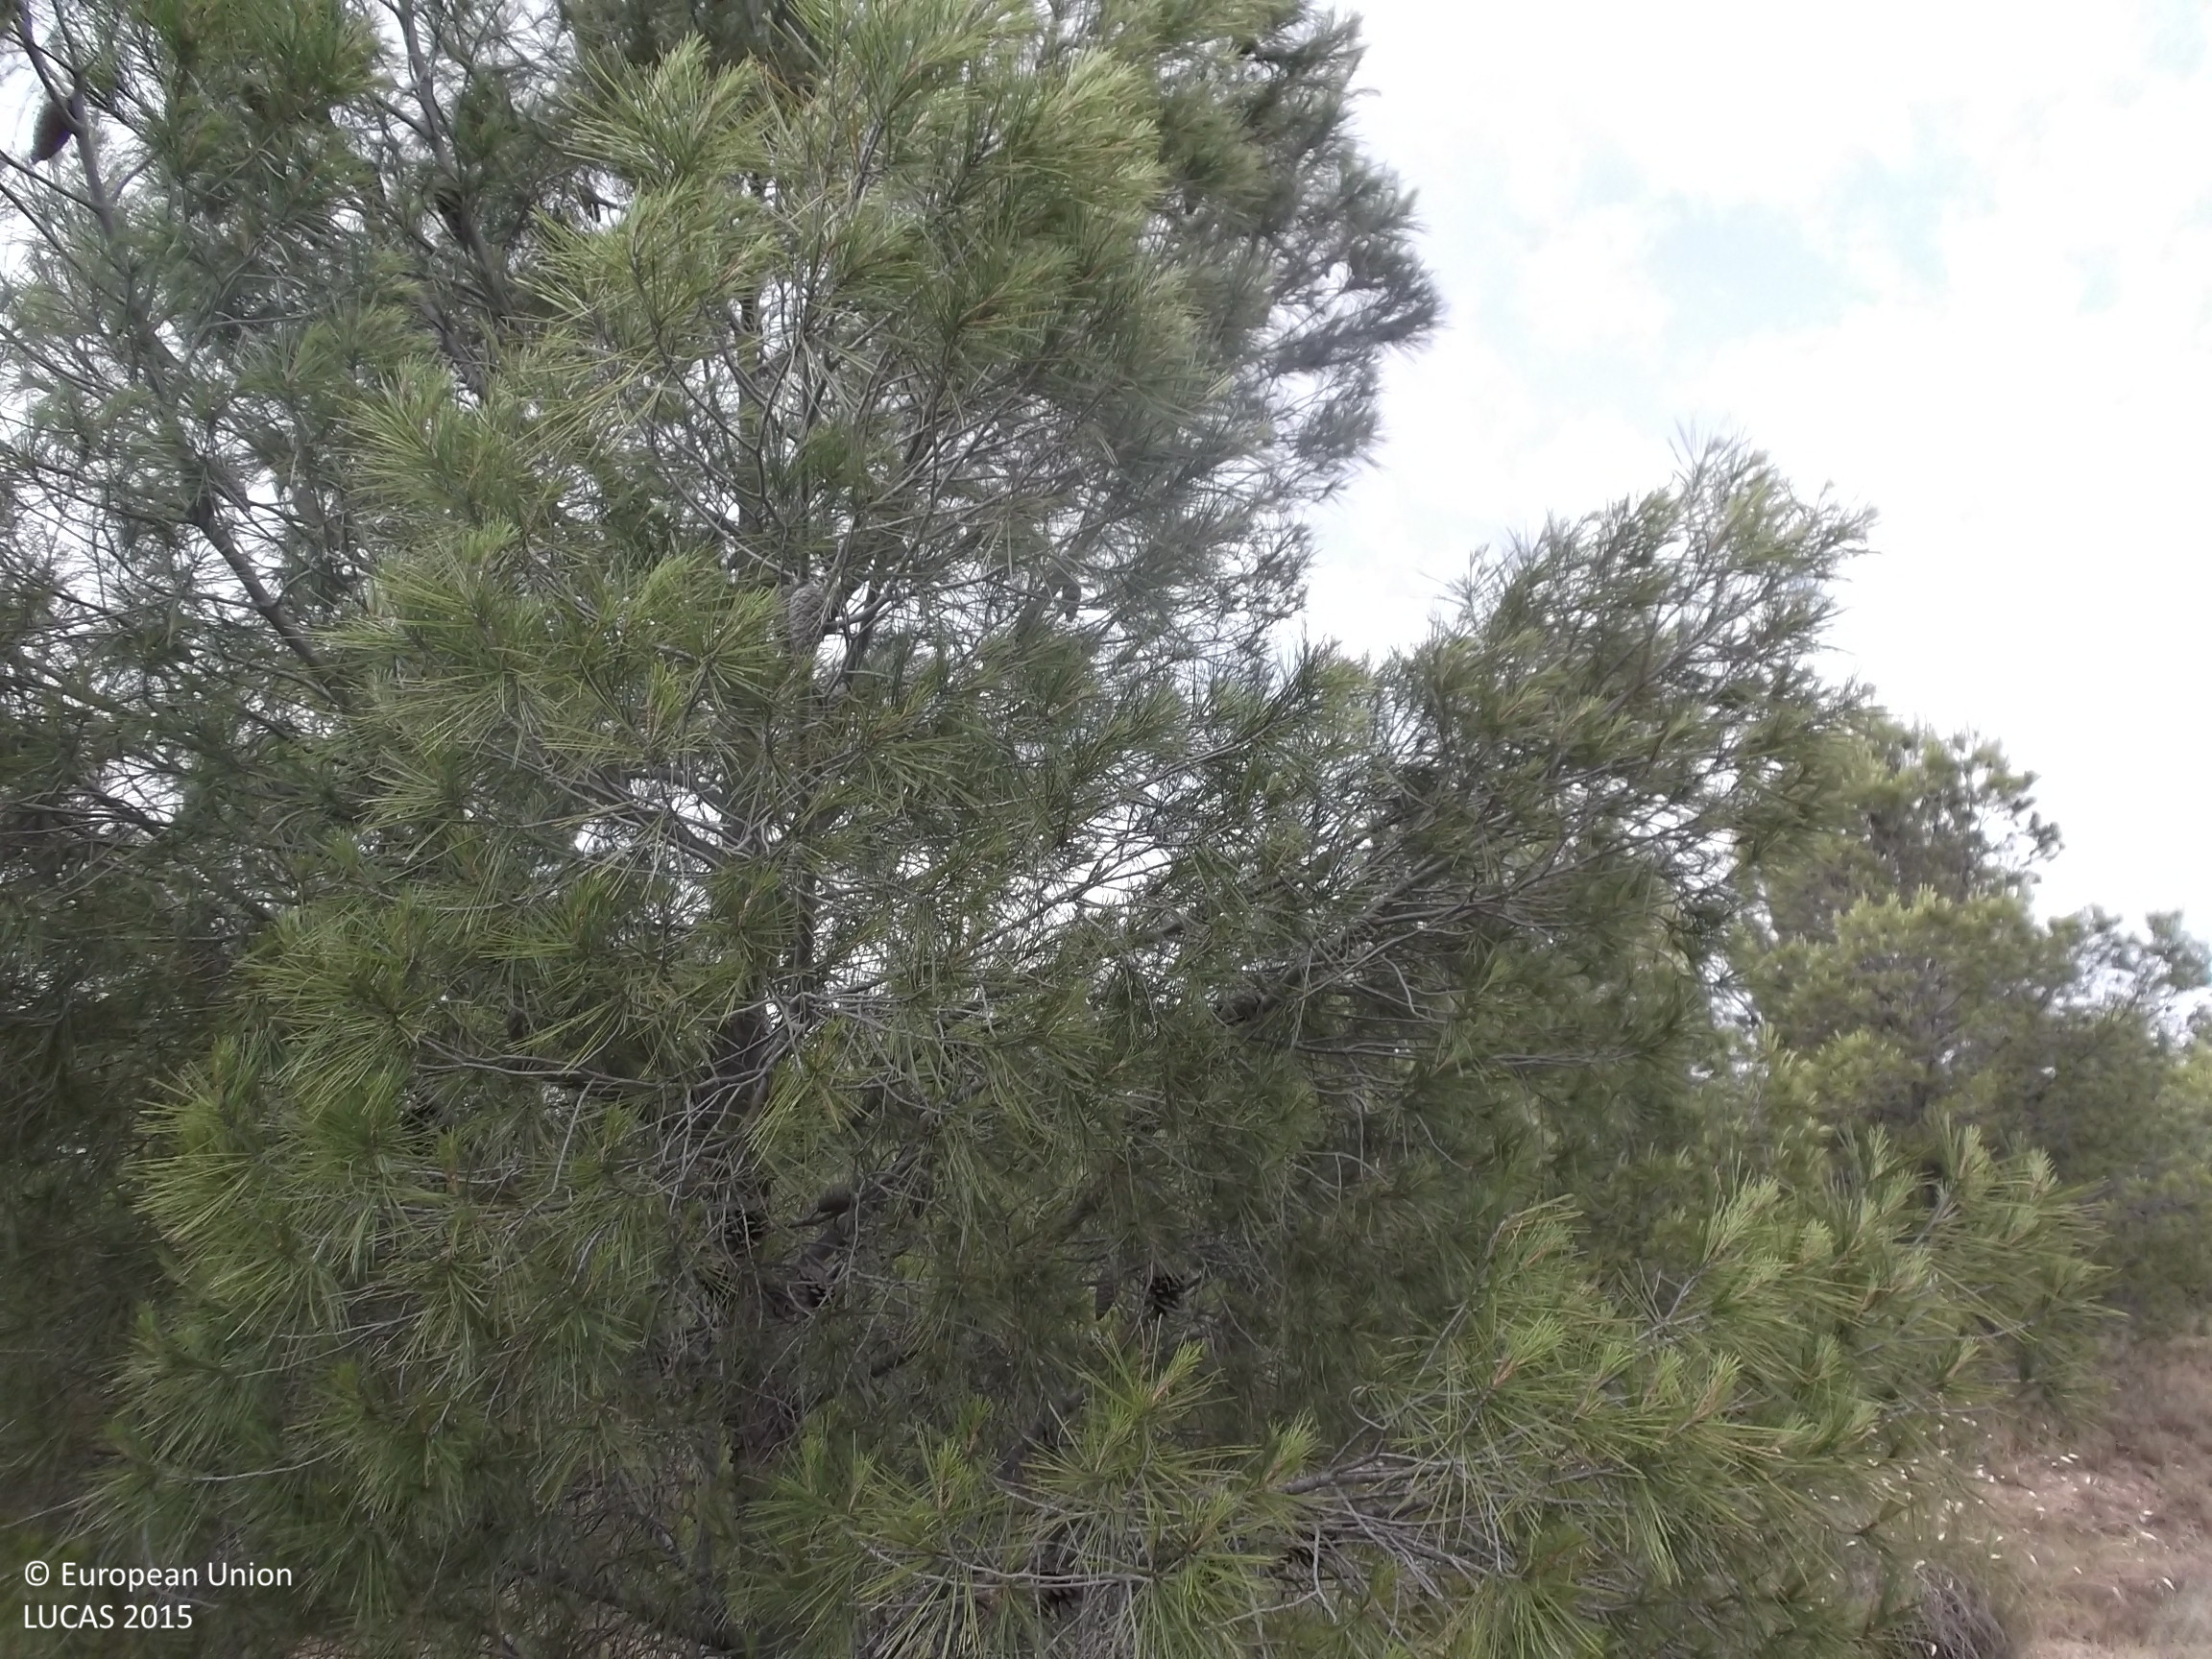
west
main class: Woodland
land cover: Pine dominated coniferous woodland
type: coniferous forest of the mediterranean region
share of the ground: 50 - 75 %
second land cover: Shrubland without tree cover
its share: 10 - 25 %
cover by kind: coniferous forest trees 70 %, shrubs 15 %, herbaceous plants 10 %, unconsolidated bare surface 5 %
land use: Forestry
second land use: Agriculture (excluding fallow land and kitchen gardens)
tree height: < 5 m
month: July
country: ES
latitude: 42.2095
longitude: -1.5518
